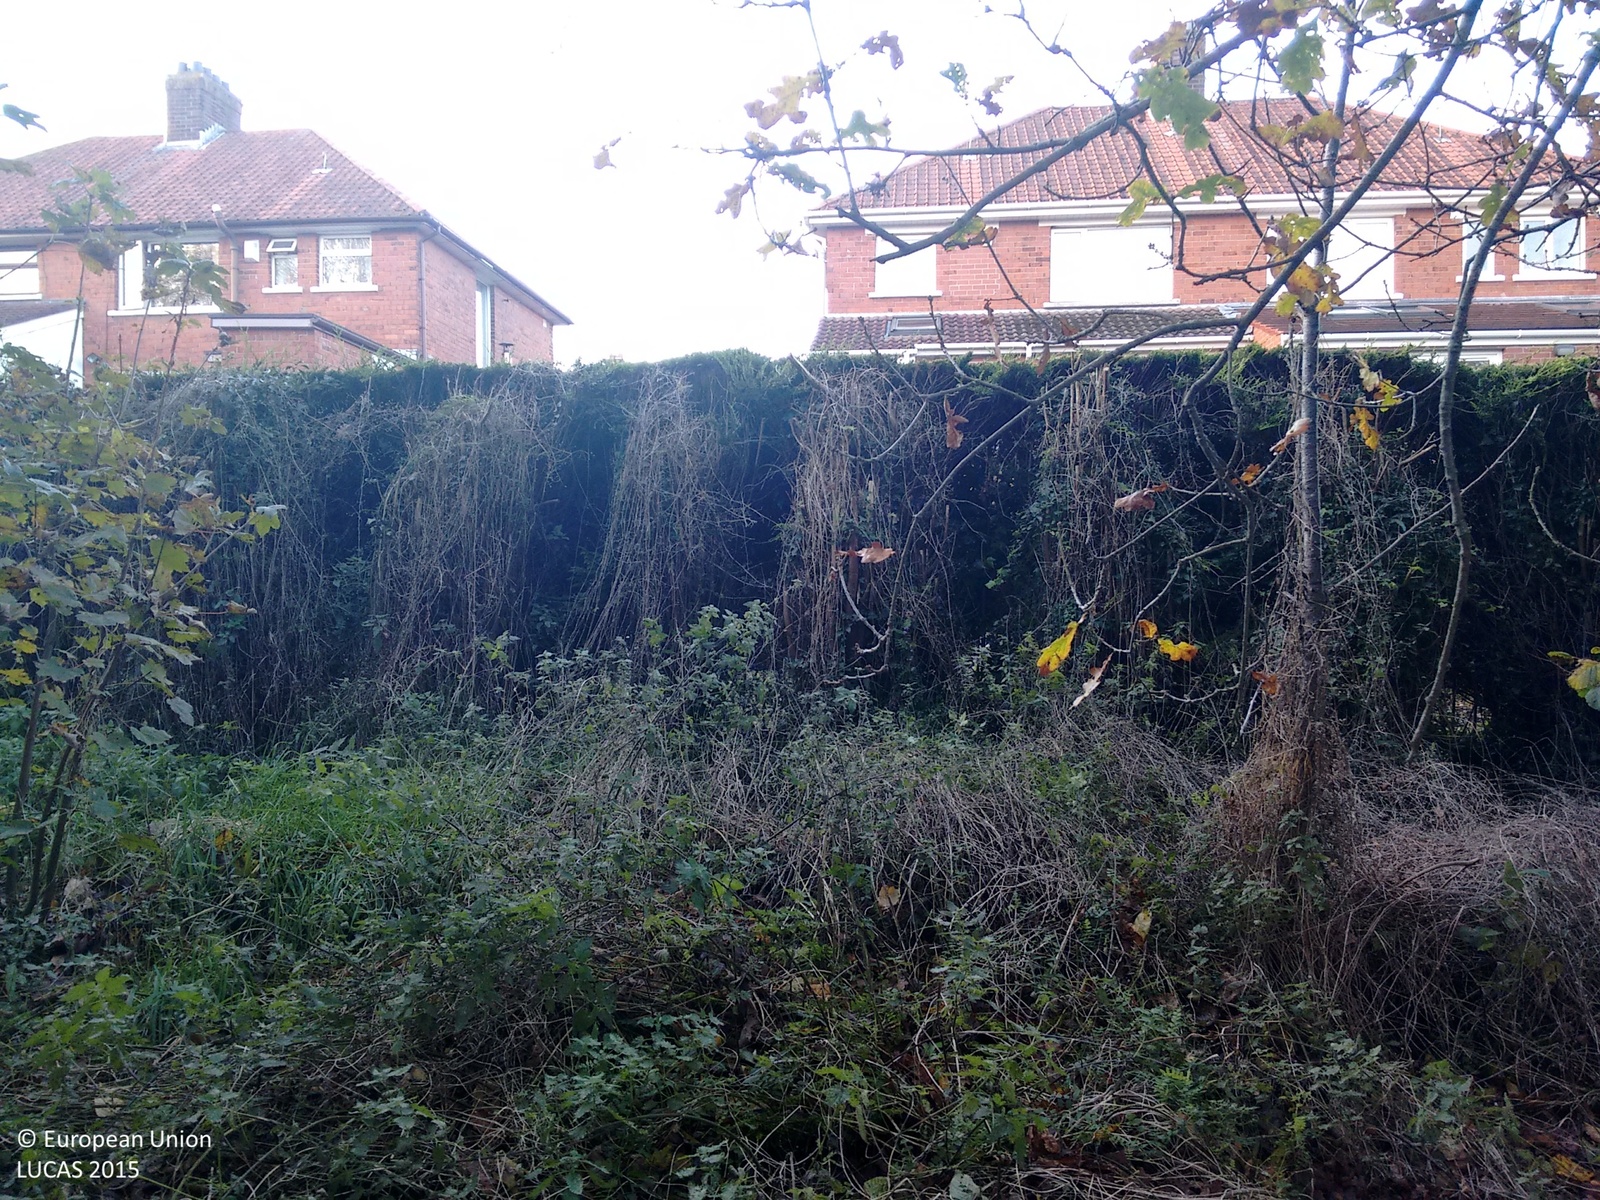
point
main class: Woodland
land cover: Broadleaved woodland
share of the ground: > 75 %
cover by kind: herbaceous plants 40 %, broadleaved forest trees 30 %
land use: Sport
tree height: > 5 m
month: November
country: GB
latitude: 54.6287
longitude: -5.9547
